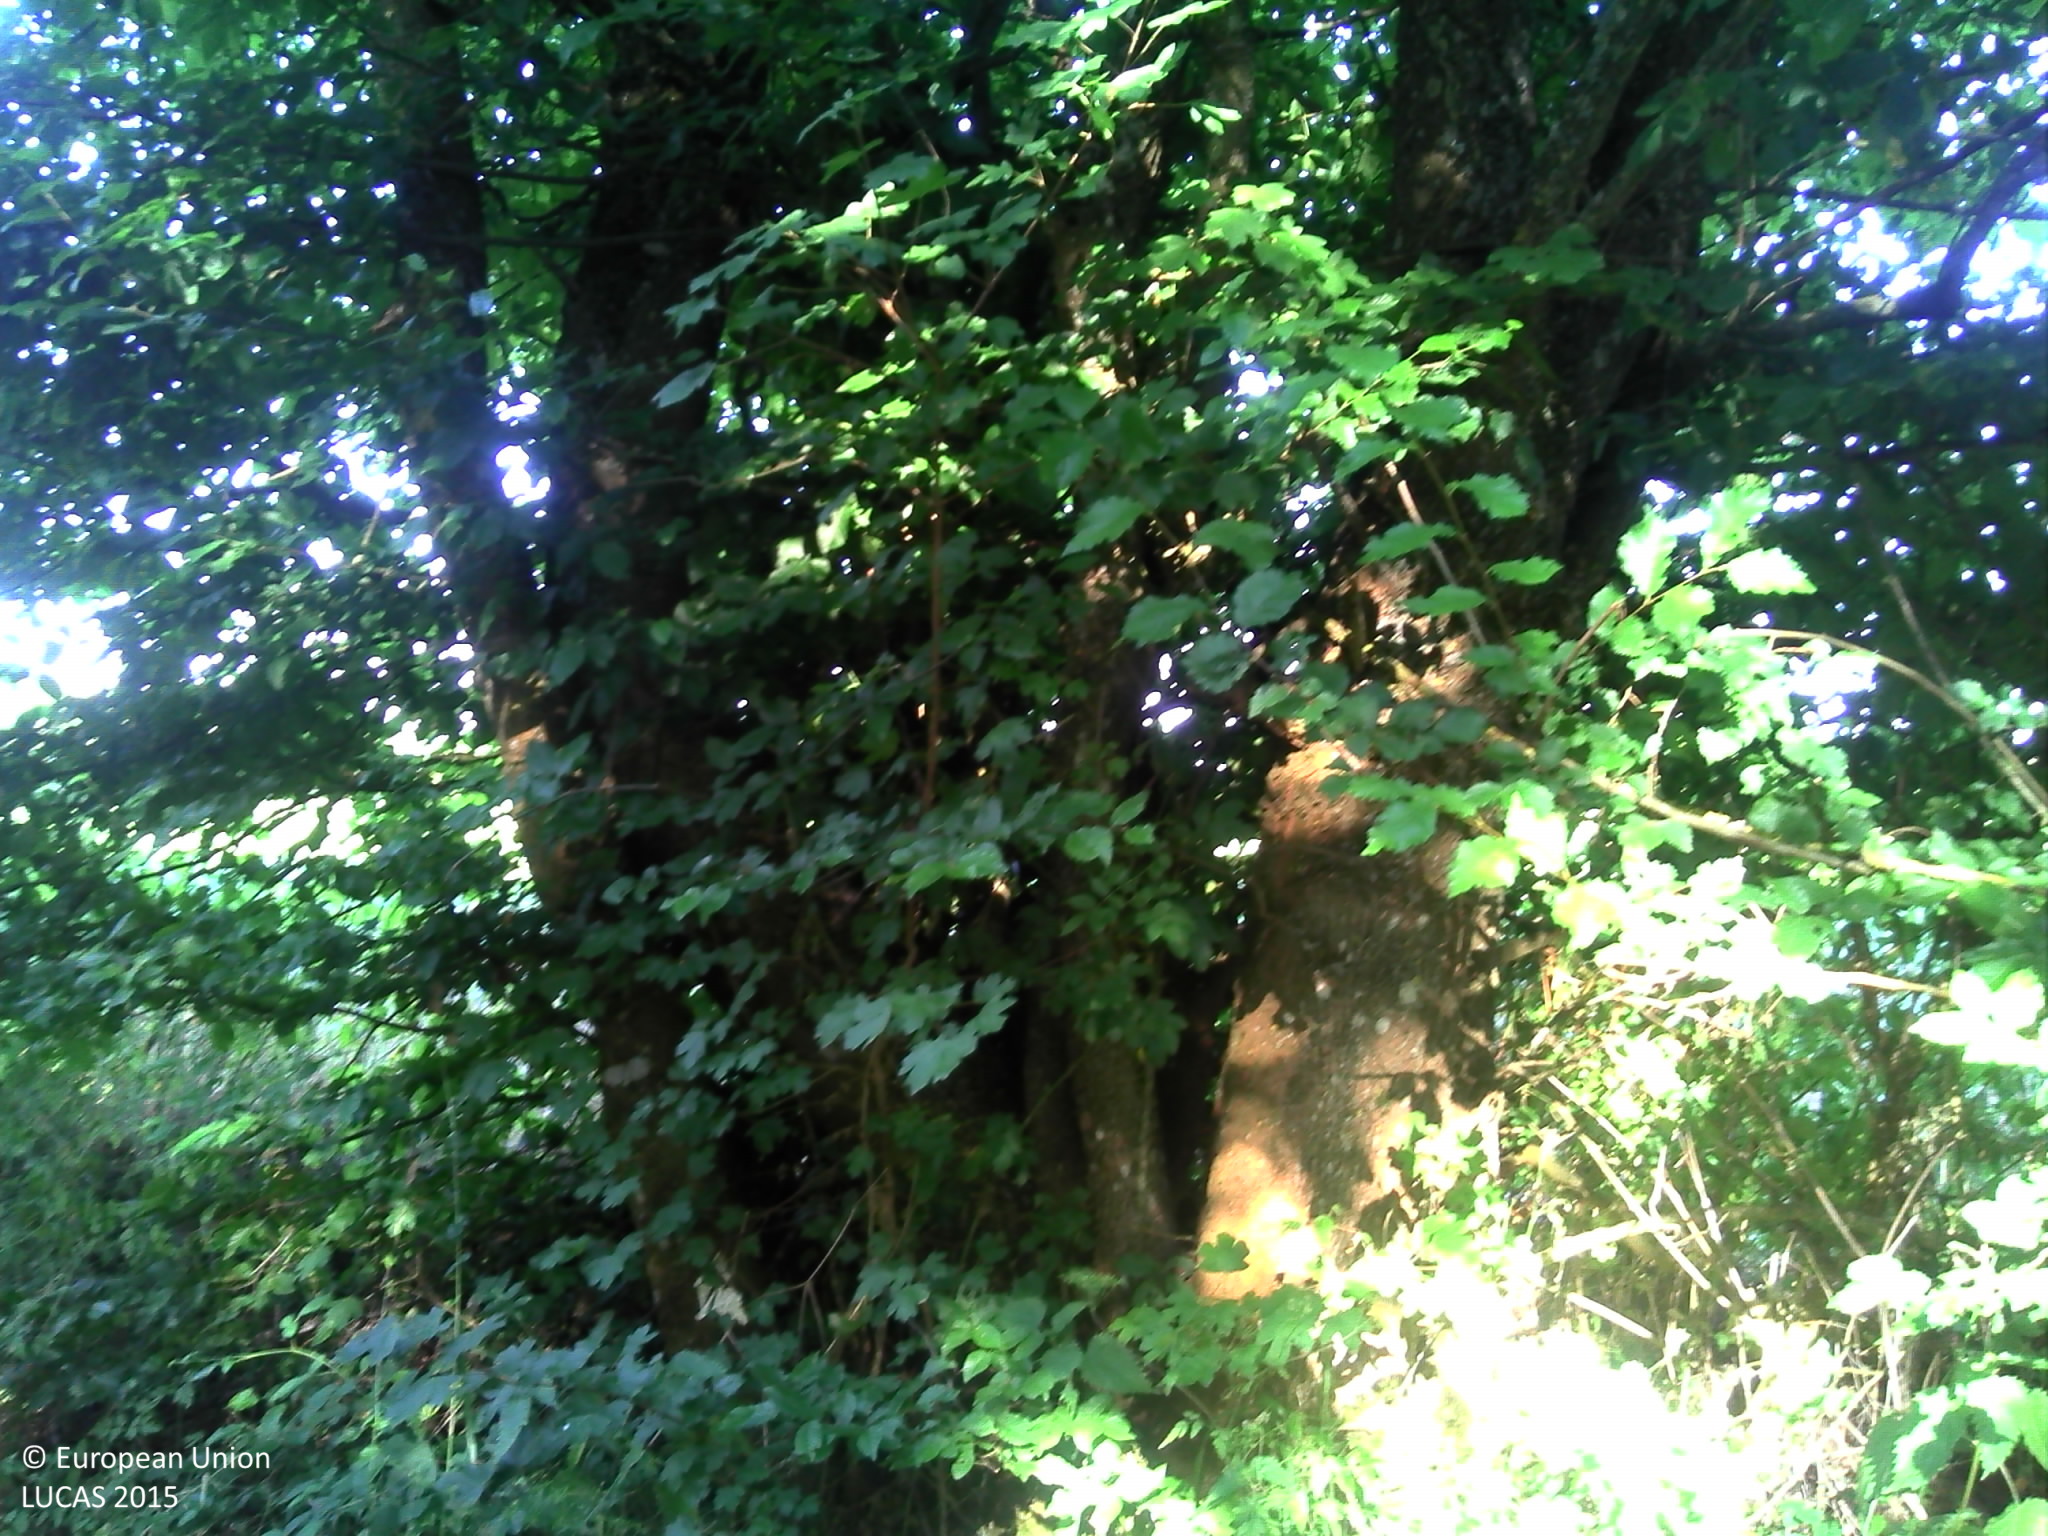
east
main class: Cropland
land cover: Sunflower
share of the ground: 25 - 50 %
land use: Agriculture (excluding fallow land and kitchen gardens)
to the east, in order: Grass margins; Ditches and canals; Lines of trees; Sunflower; Lines of trees; Fences; Grassland without tree/shrub cover
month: June
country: FR
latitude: 47.6335
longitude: 2.6324
